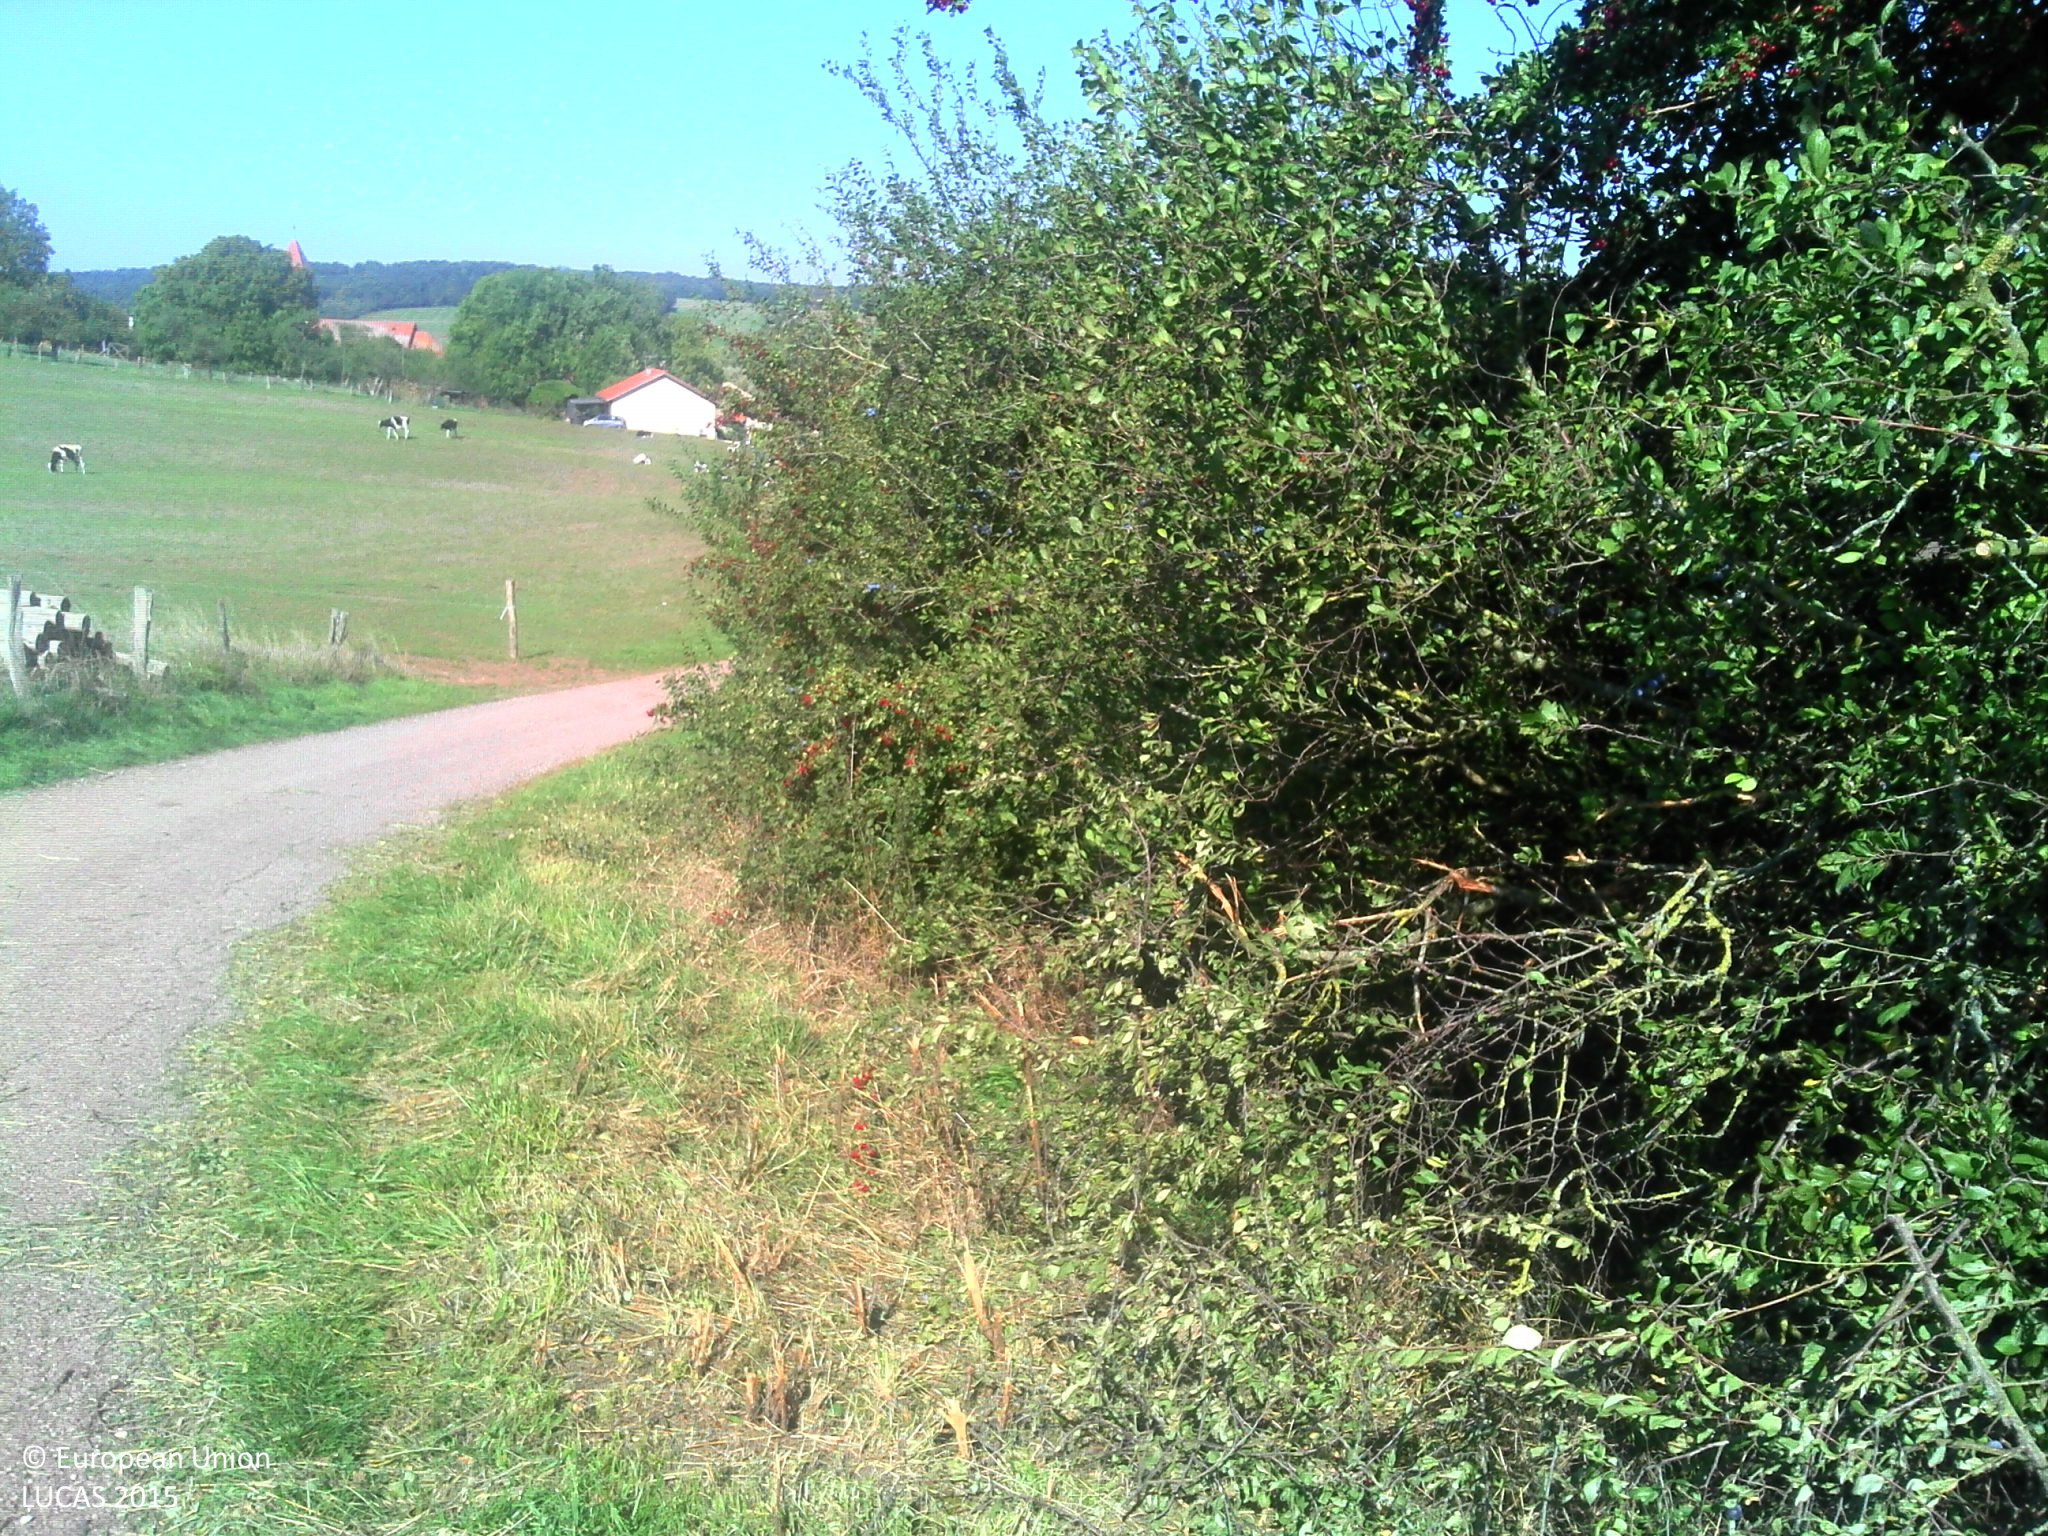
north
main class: Woodland
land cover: Broadleaved woodland
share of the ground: > 75 %
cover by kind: broadleaved forest trees 60 %, shrubs 30 %, herbaceous plants 10 %
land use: Semi-natural and natural areas not in use
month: October
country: FR
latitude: 48.7436
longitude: 6.4781
